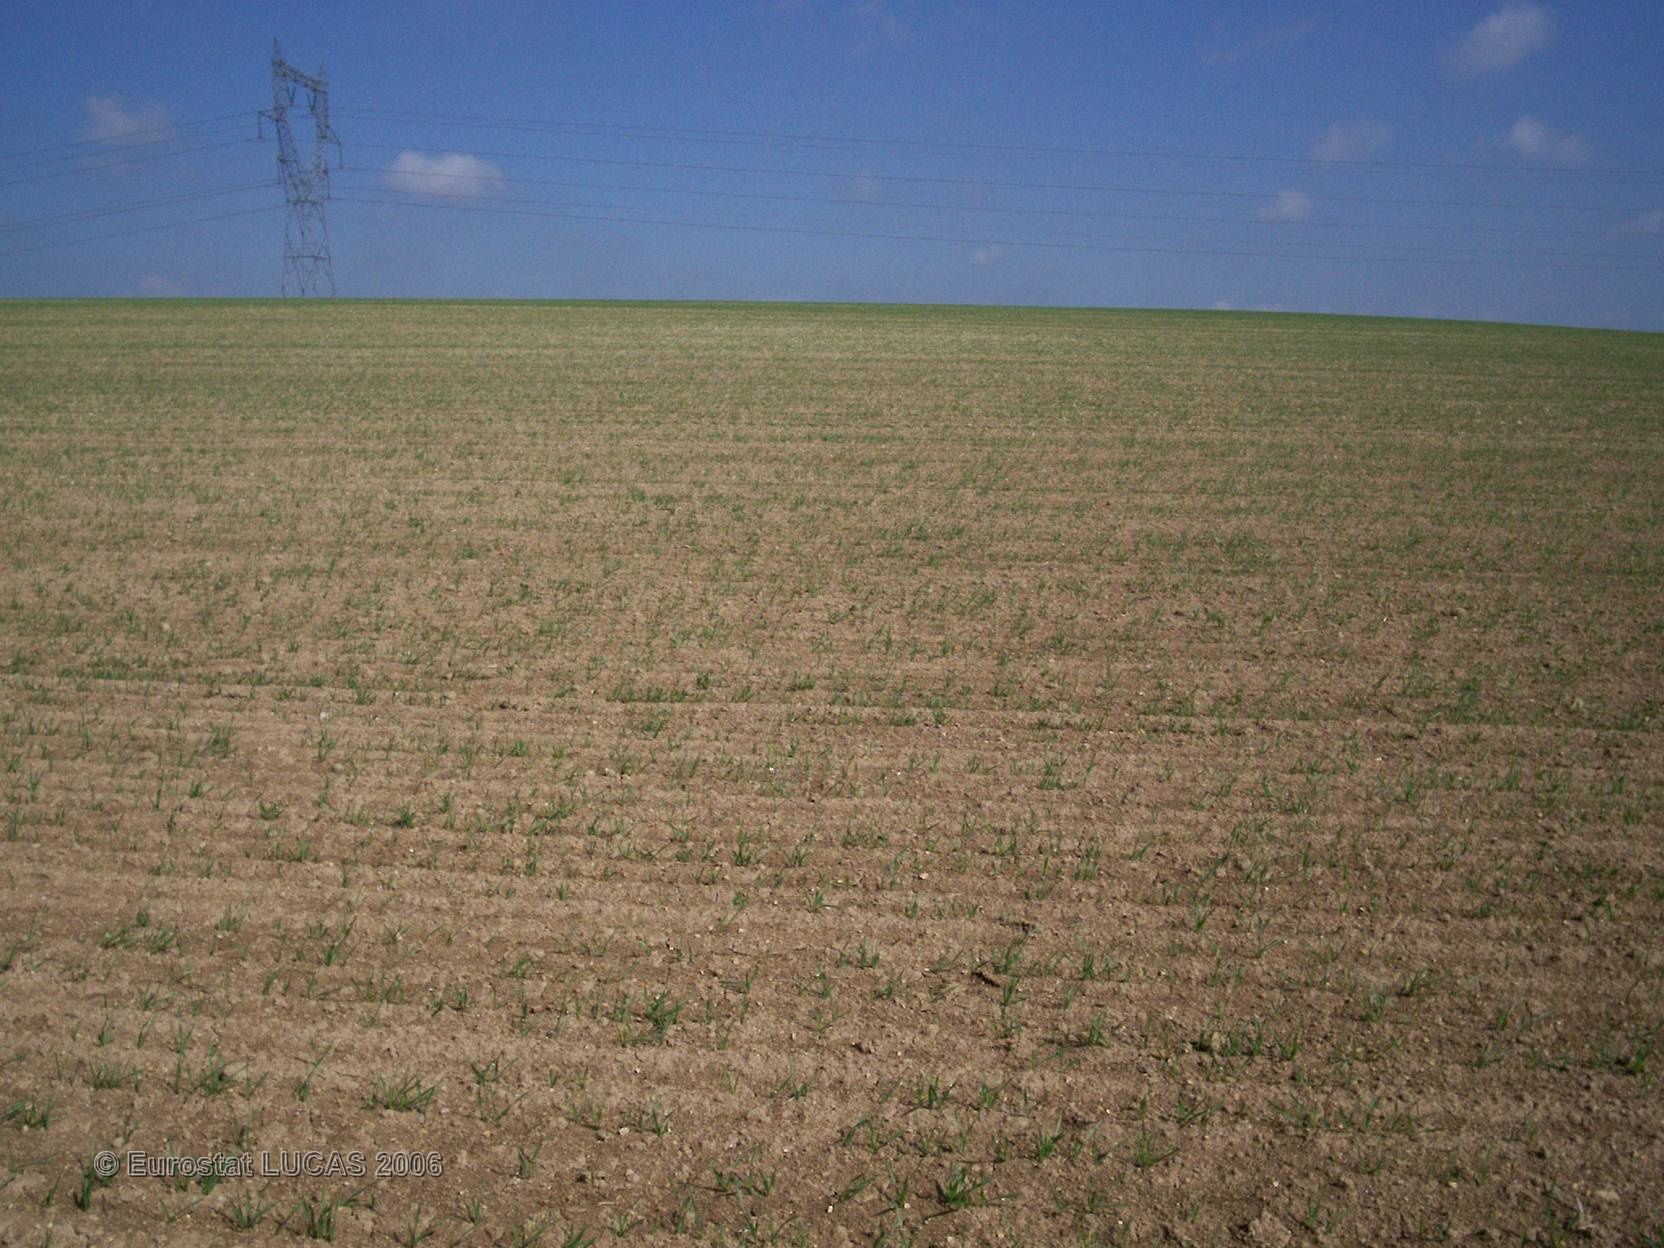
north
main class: Cropland
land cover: Barley
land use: Agriculture (excluding fallow land and kitchen gardens)
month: April
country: FR
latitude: 48.5198
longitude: 4.5140
